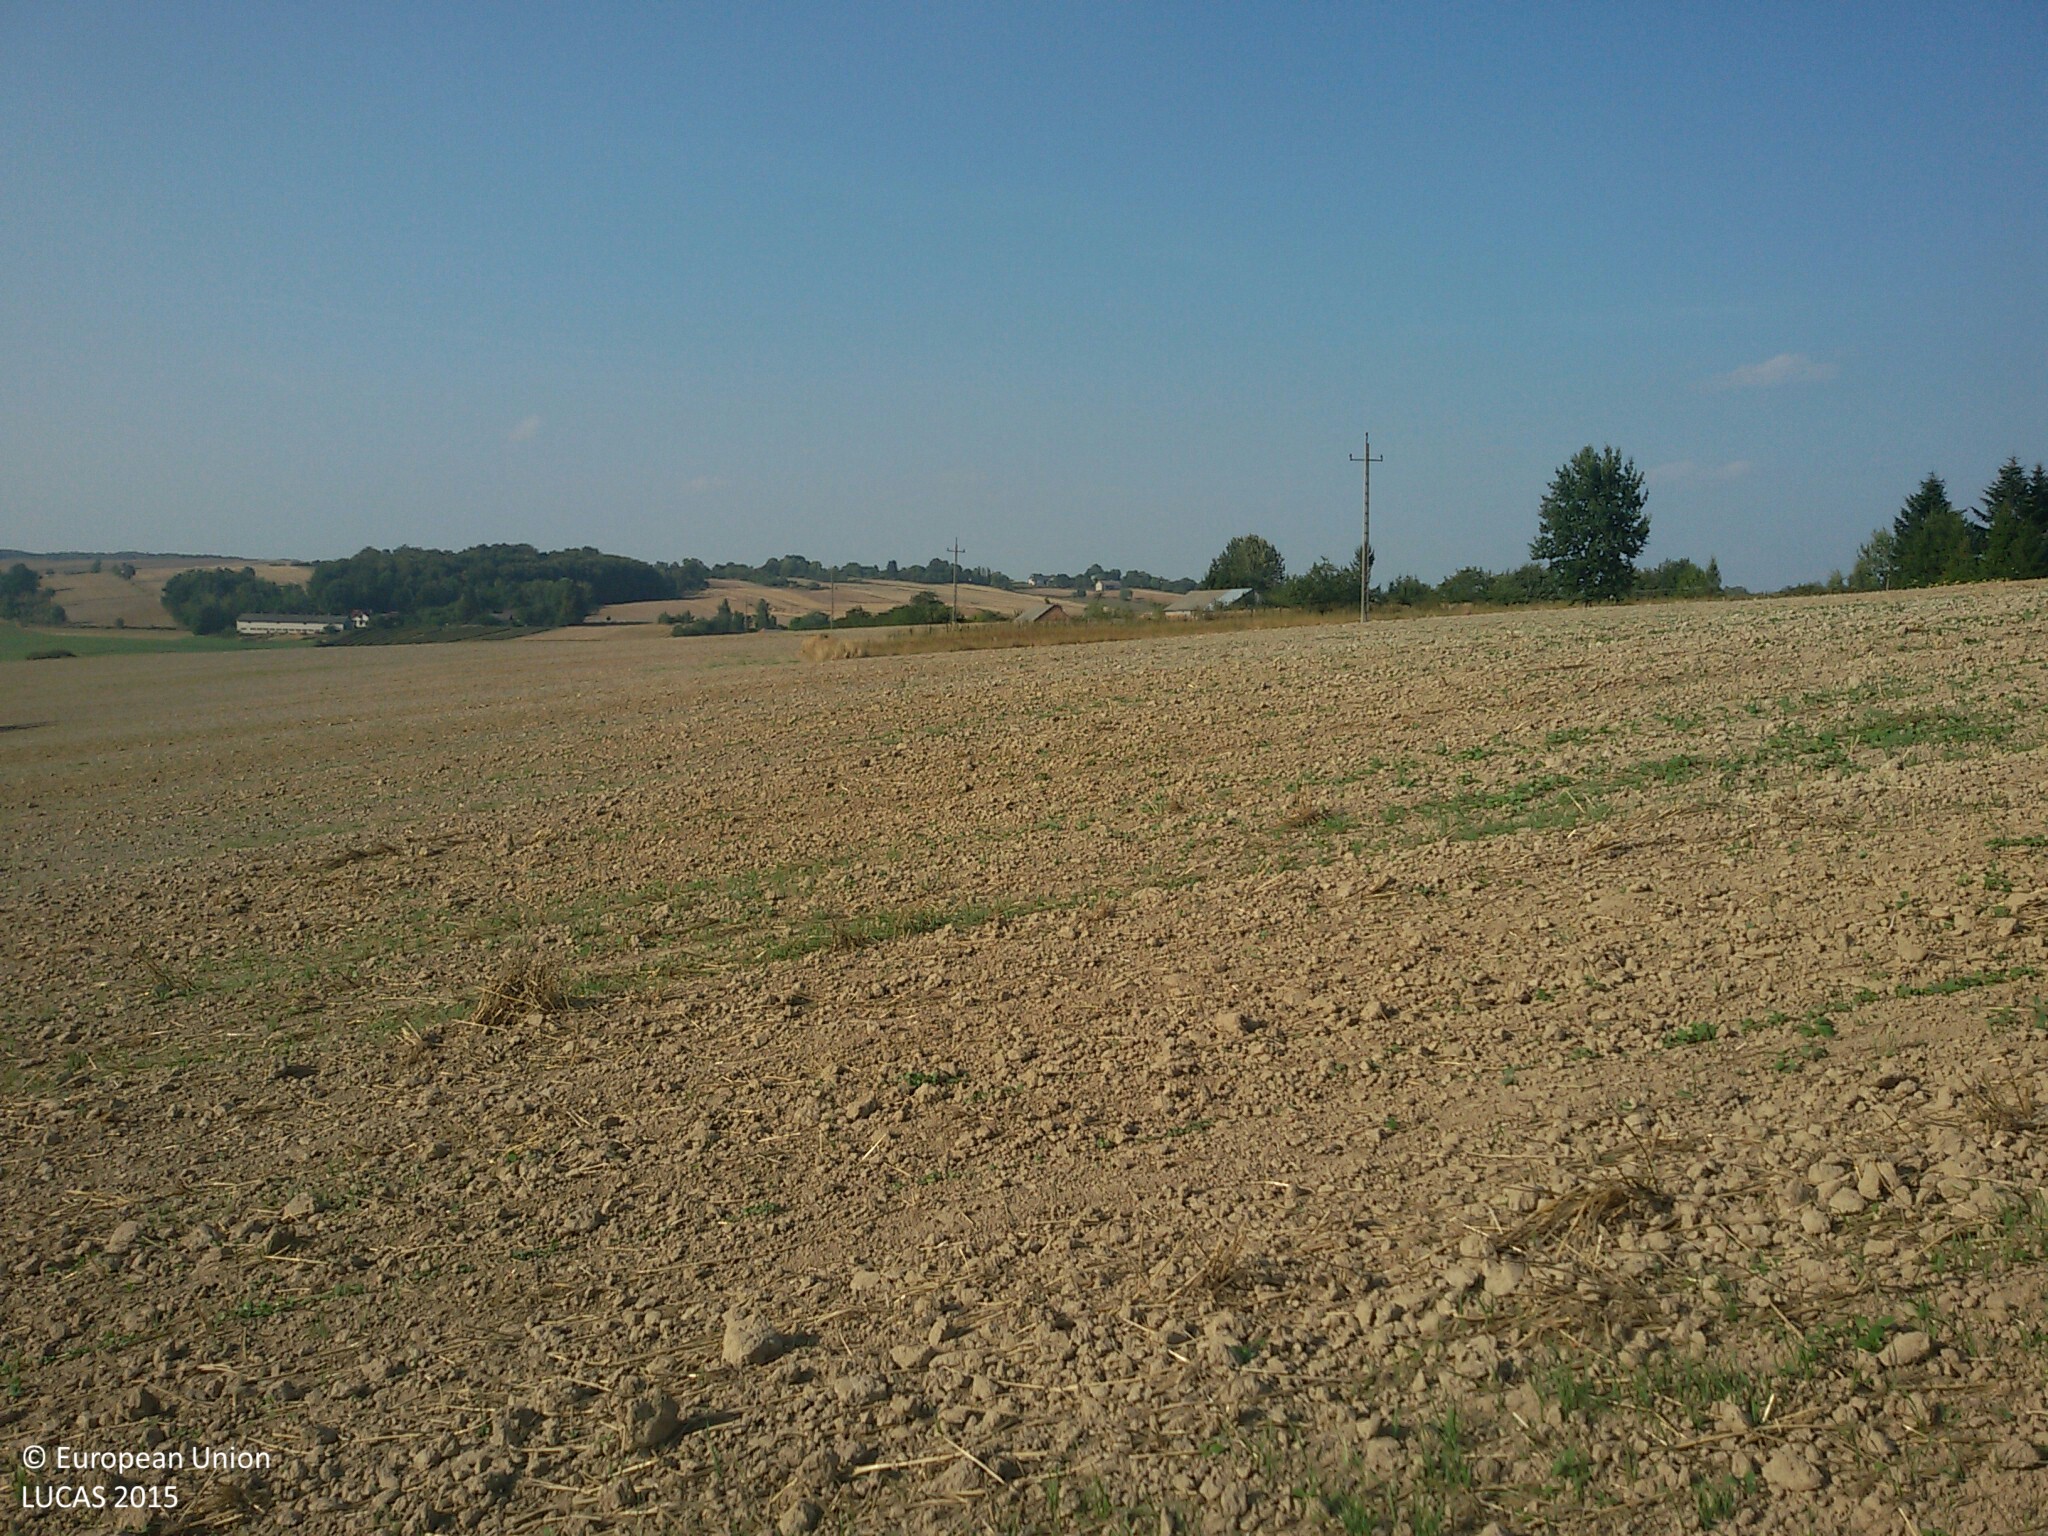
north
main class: Cropland
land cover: Common wheat
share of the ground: < 10 %
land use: Agriculture (excluding fallow land and kitchen gardens)
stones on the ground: < 10 %
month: September
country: PL
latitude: 50.6016
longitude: 23.3190
